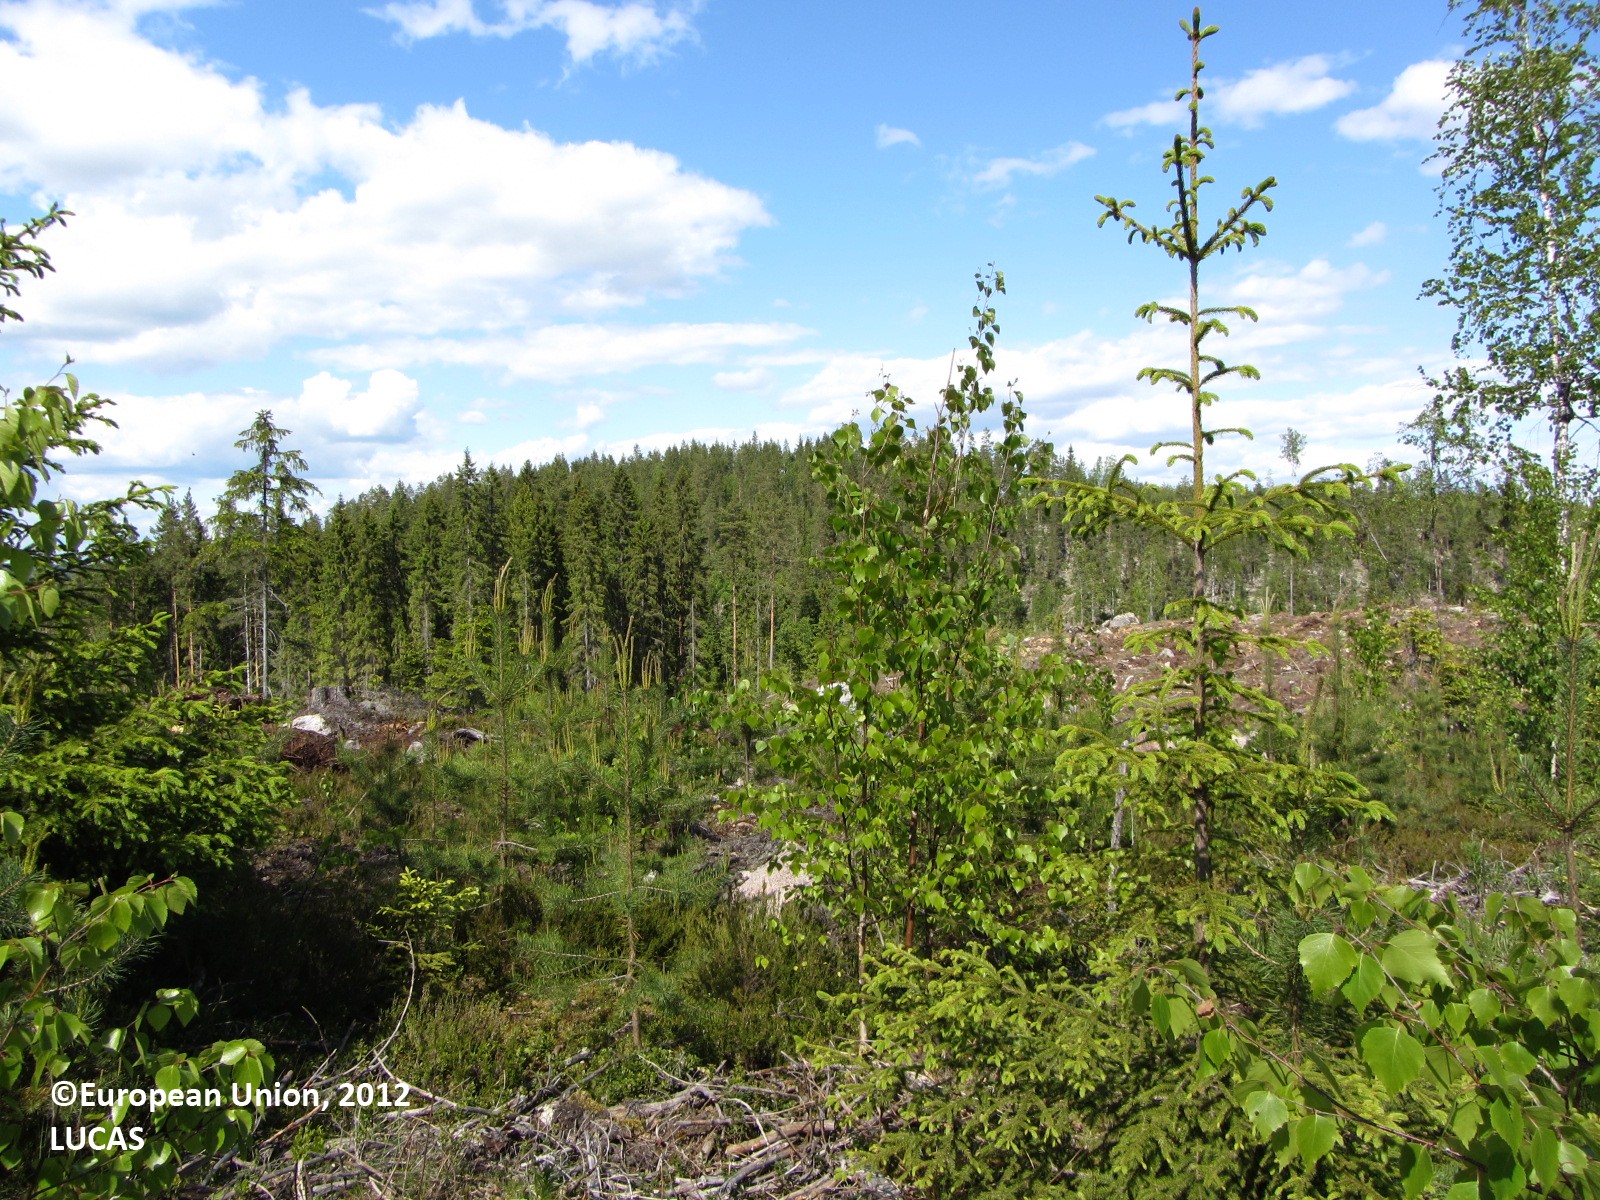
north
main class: Woodland
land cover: Other mixed woodland
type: hemiboreal forest and nemoral coniferous forest and mixed broadleaved-coniferous forest
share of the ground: > 75 %
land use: Forestry
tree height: < 5 m
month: June
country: FI
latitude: 61.7318
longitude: 25.1197
